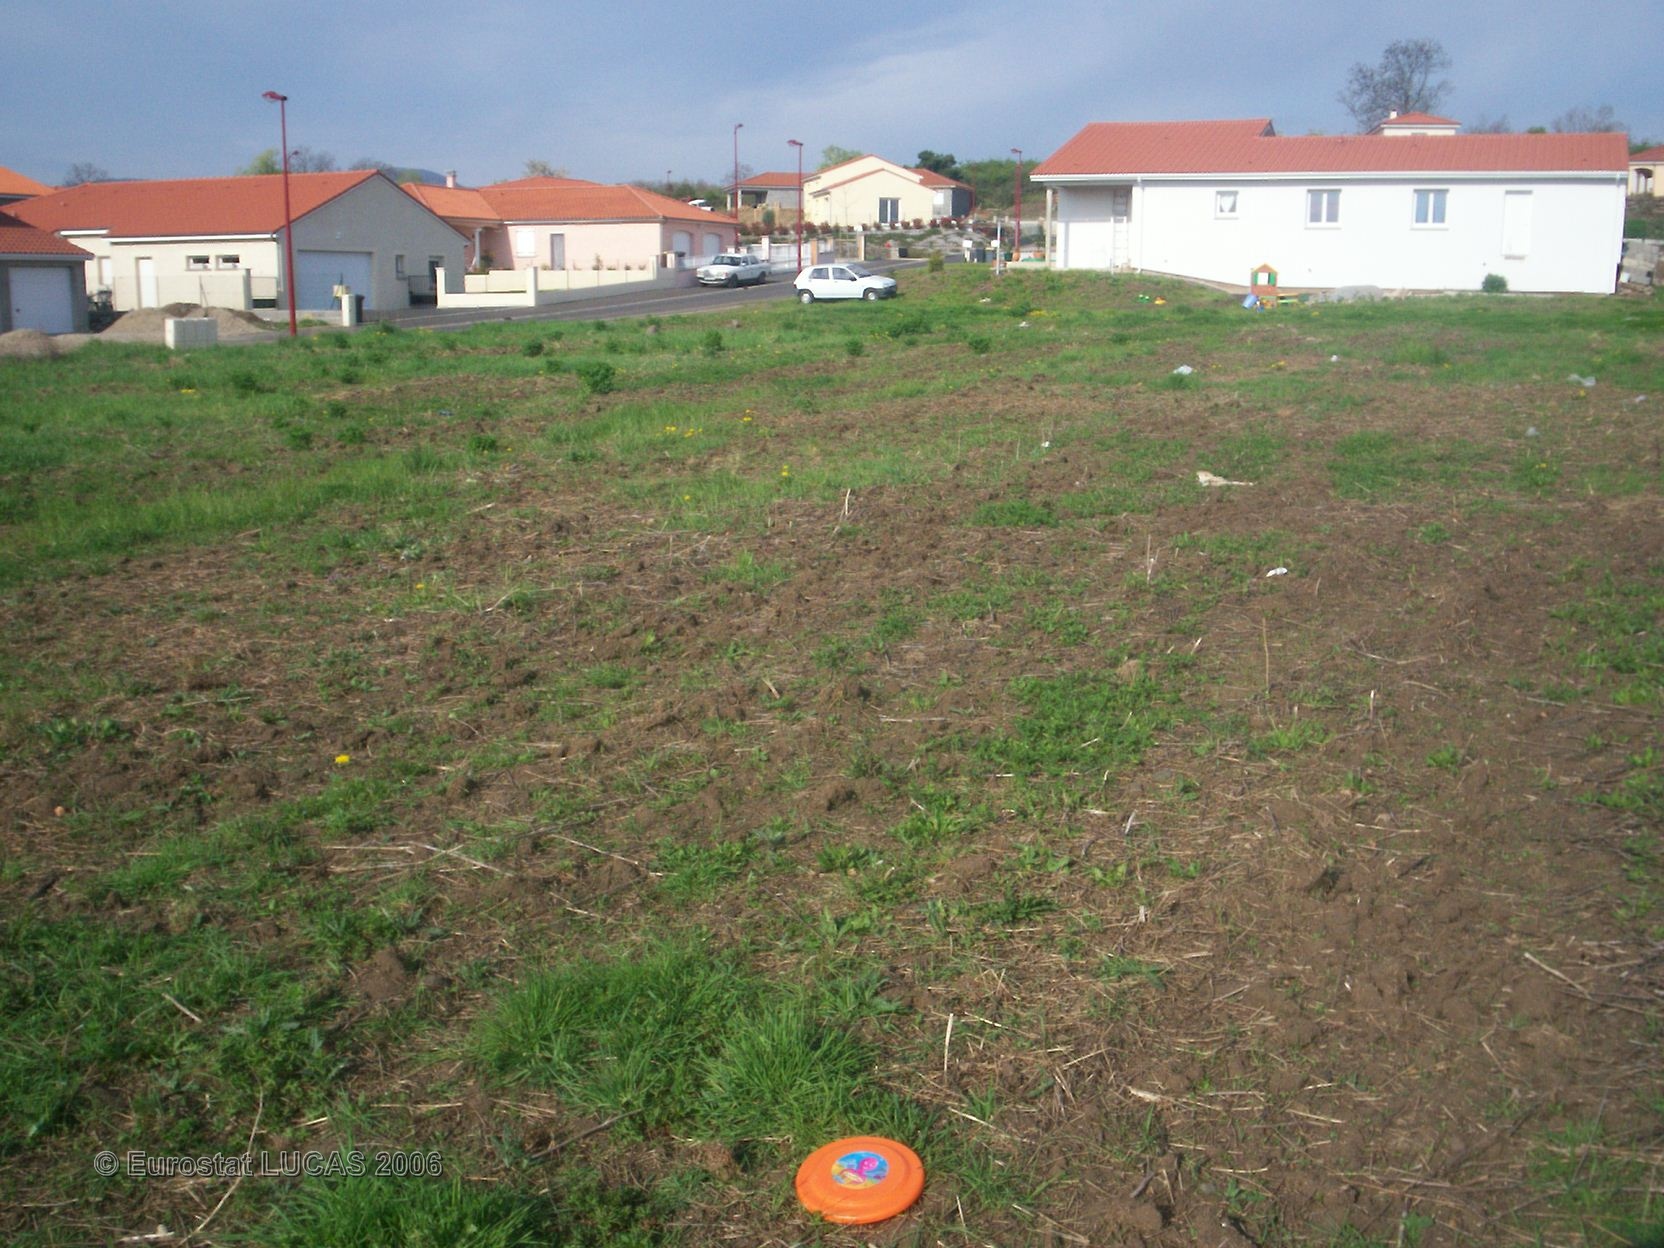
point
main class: Grassland
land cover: Grassland without tree/shrub cover
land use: Fallow land
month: April
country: FR
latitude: 45.8561
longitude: 3.0834
